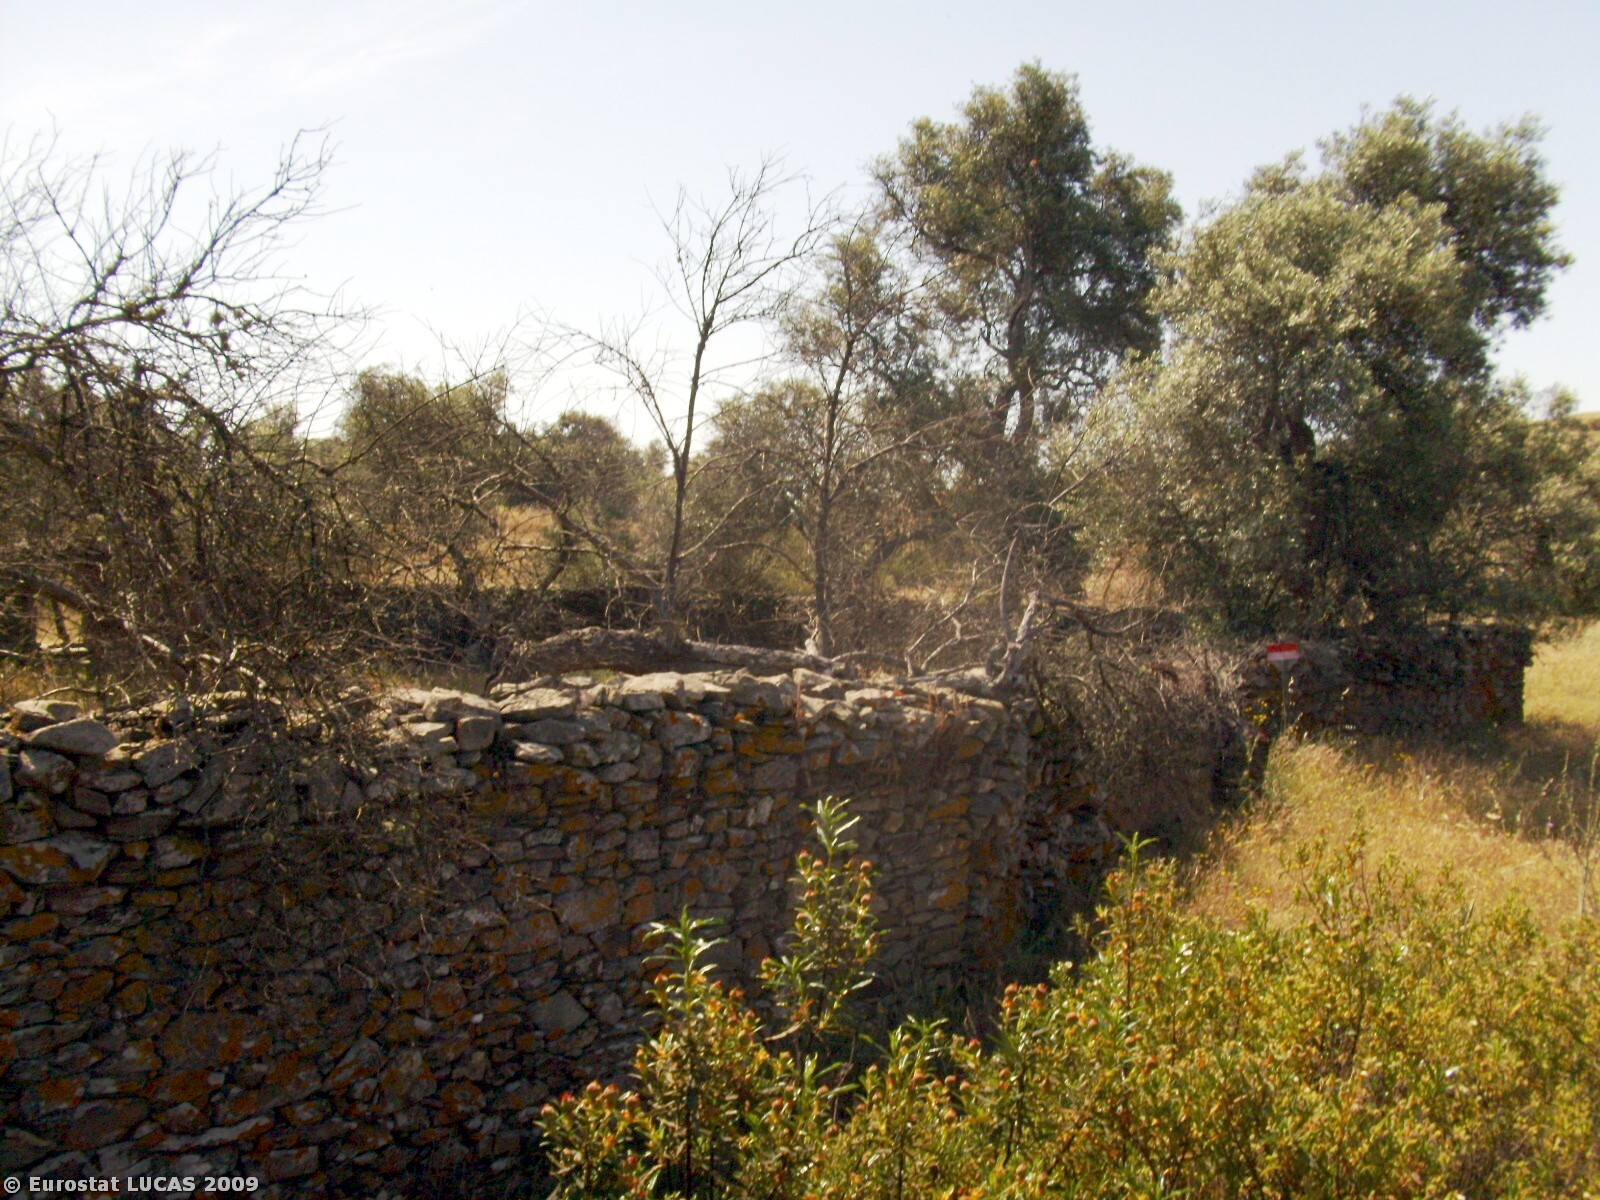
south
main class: Shrubland
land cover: Shrubland without tree cover
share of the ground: 50 - 75 %
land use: Unused
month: May
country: PT
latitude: 37.5424
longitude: -7.6582
